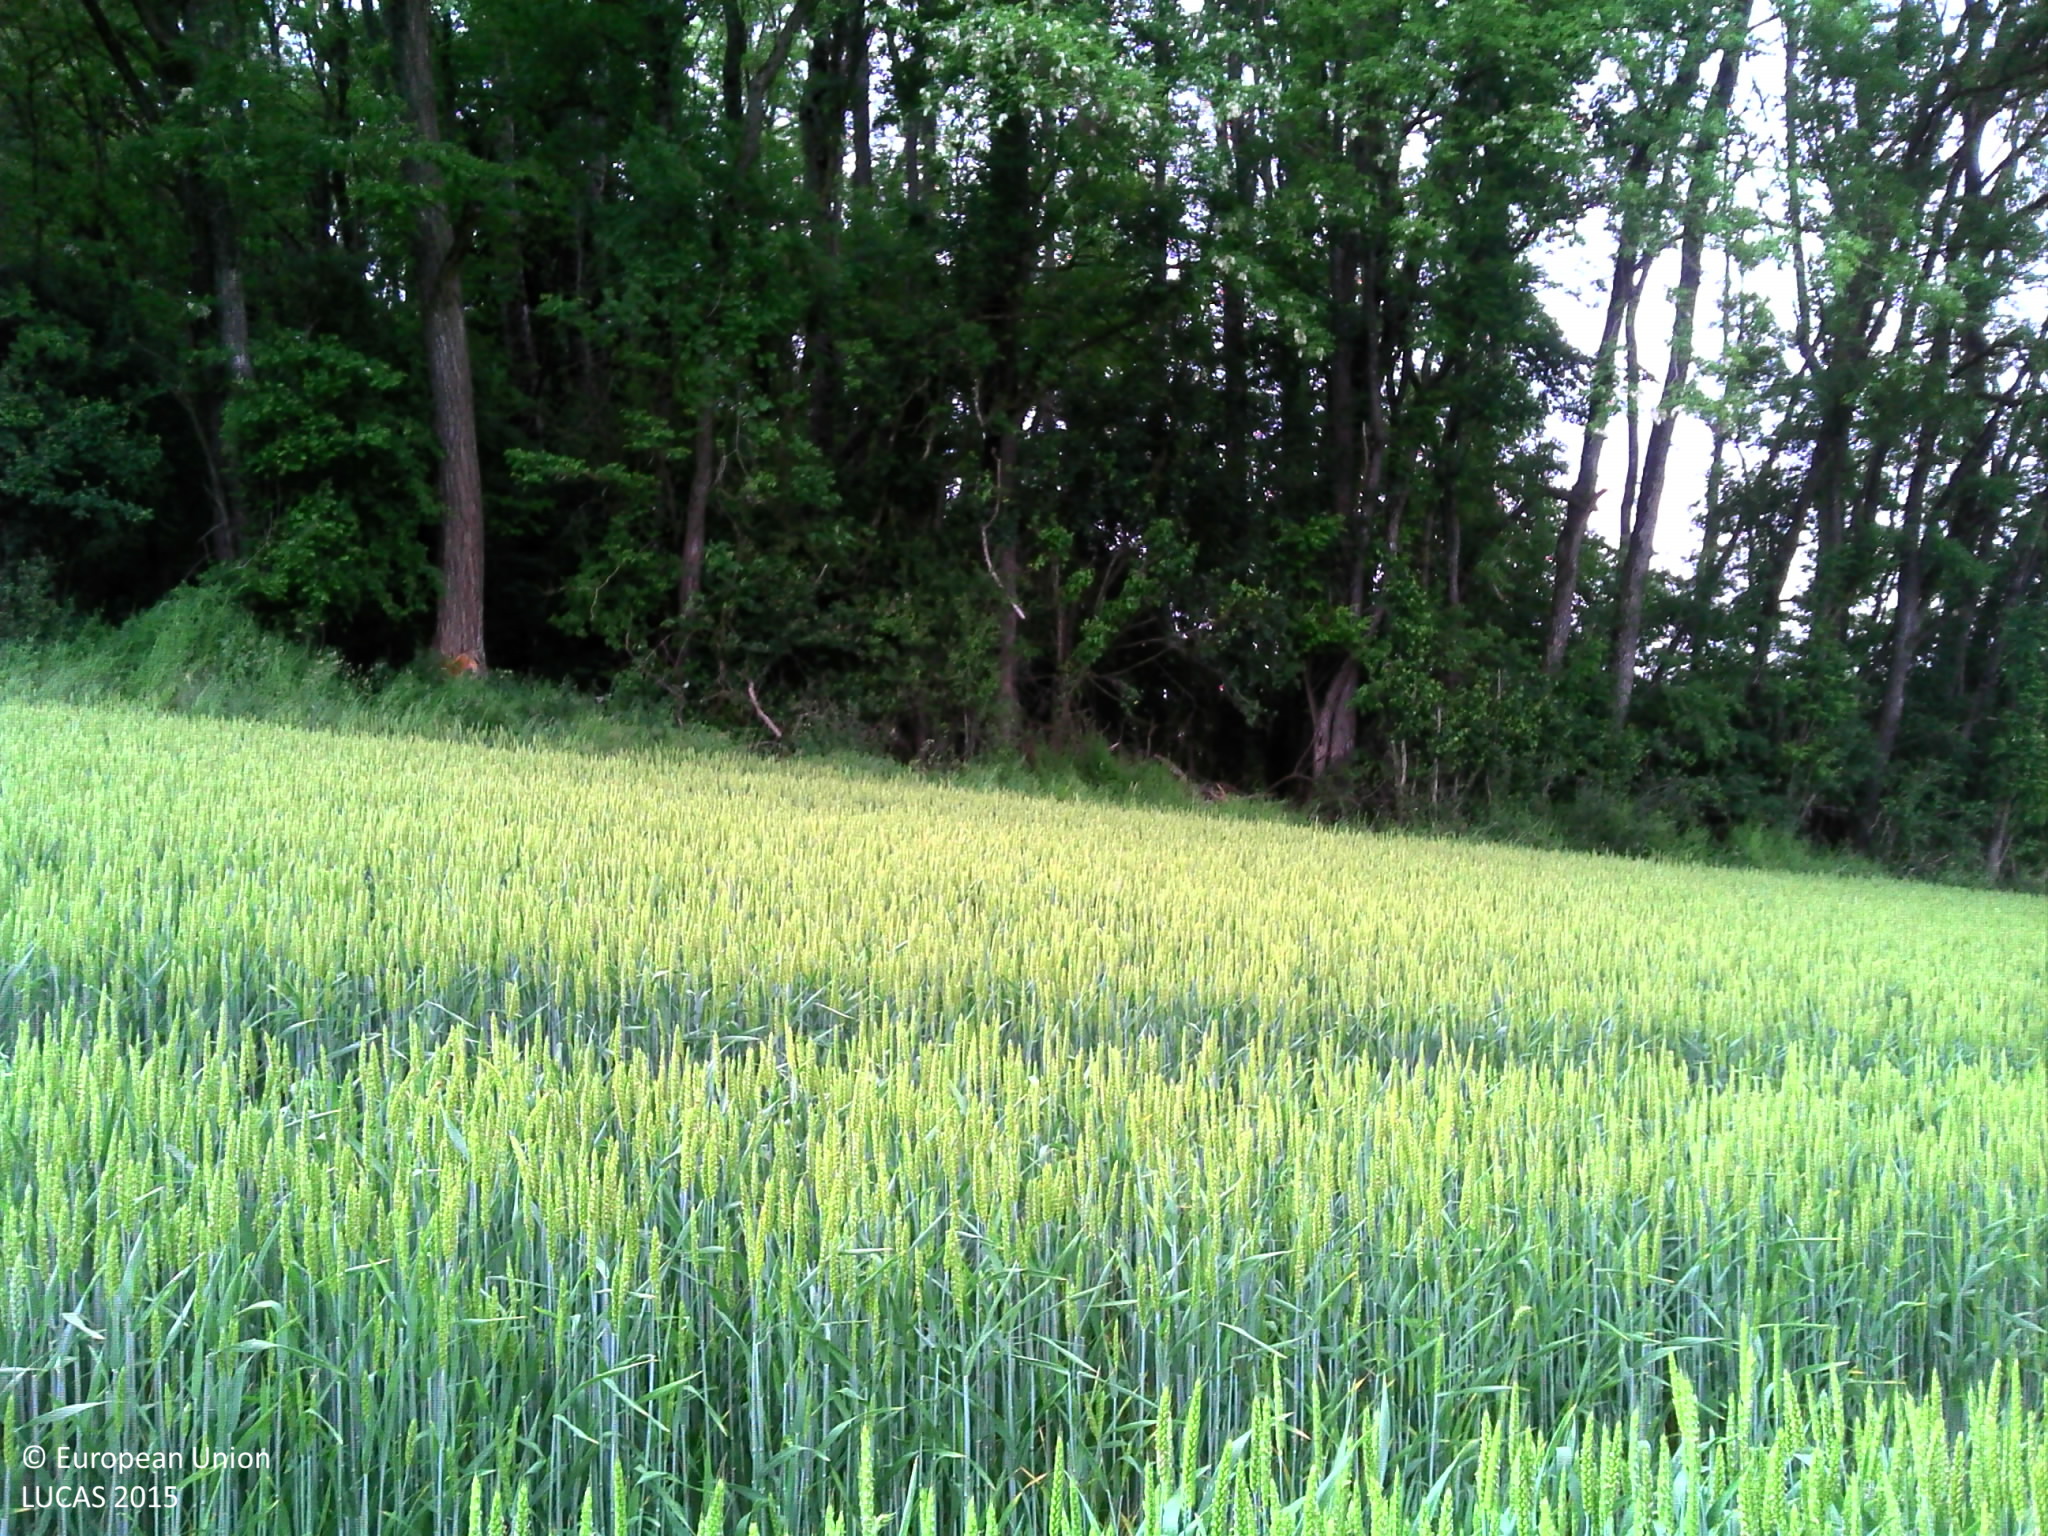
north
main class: Cropland
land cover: Common wheat
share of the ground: > 75 %
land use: Agriculture (excluding fallow land and kitchen gardens)
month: May
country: FR
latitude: 47.8818
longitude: 6.0292
